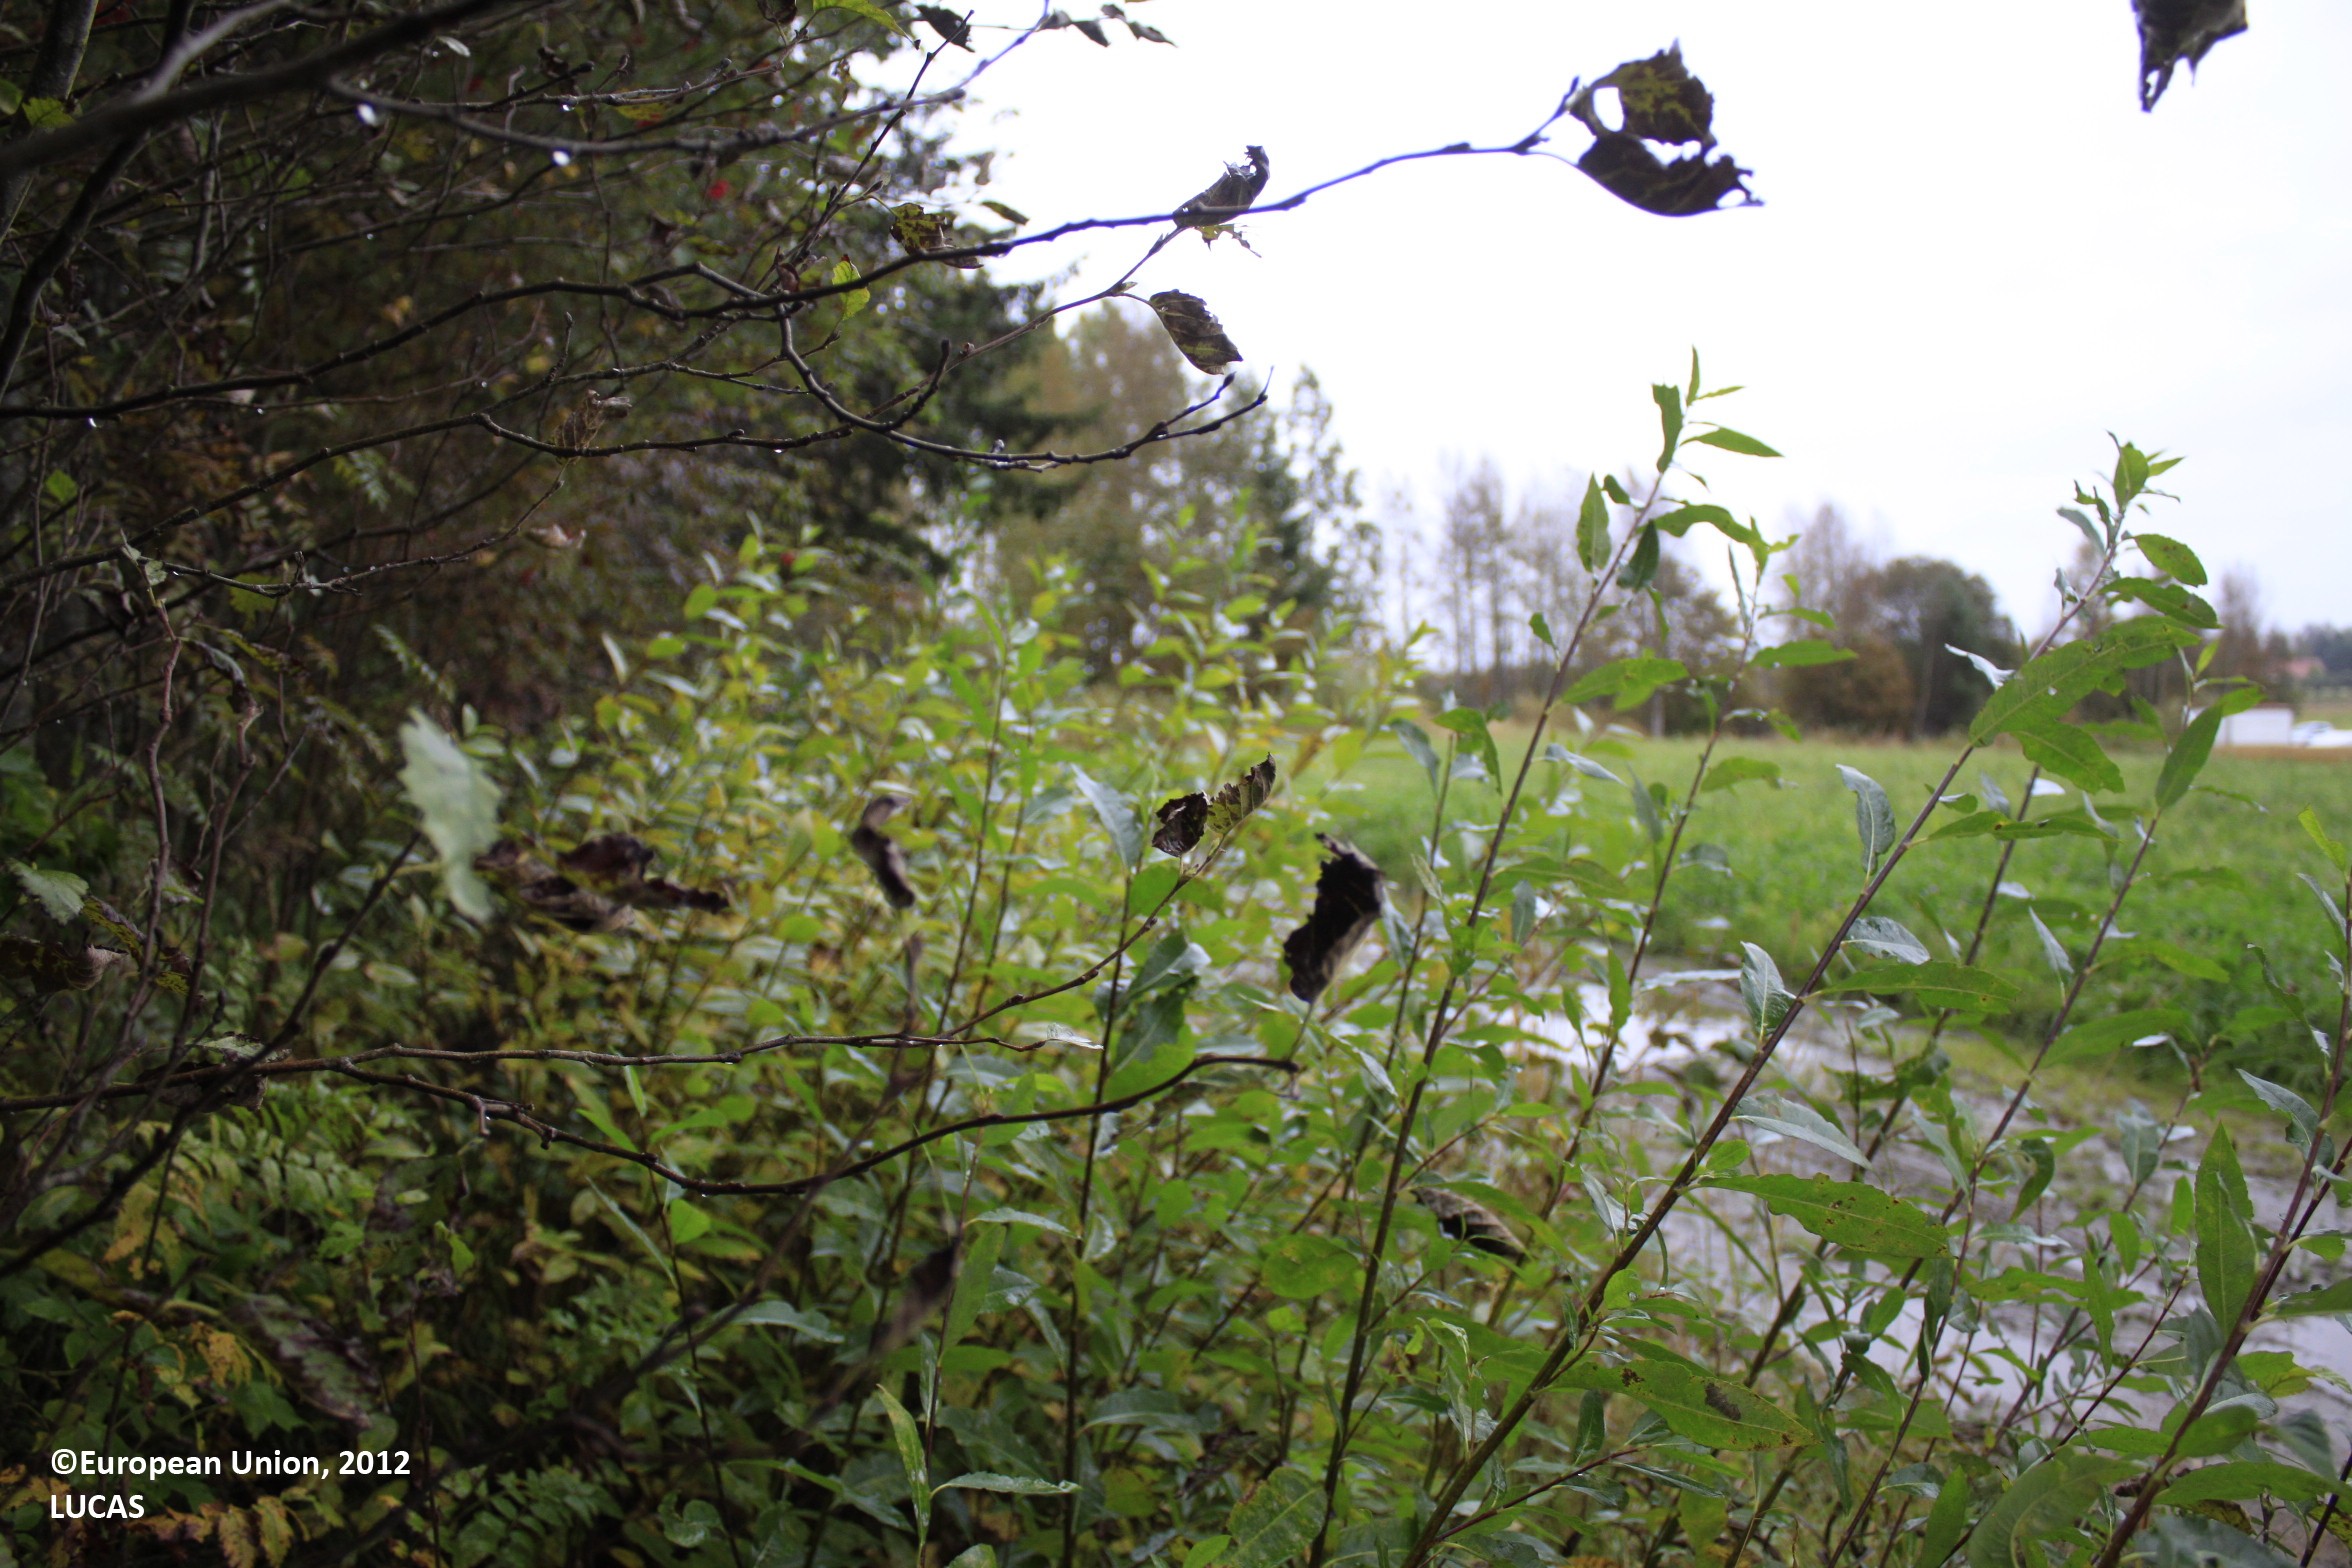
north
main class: Woodland
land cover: Spruce dominated mixed woodland
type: boreal forest
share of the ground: 50 - 75 %
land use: Forestry
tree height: > 5 m
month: September
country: FI
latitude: 63.6559
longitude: 25.9663
